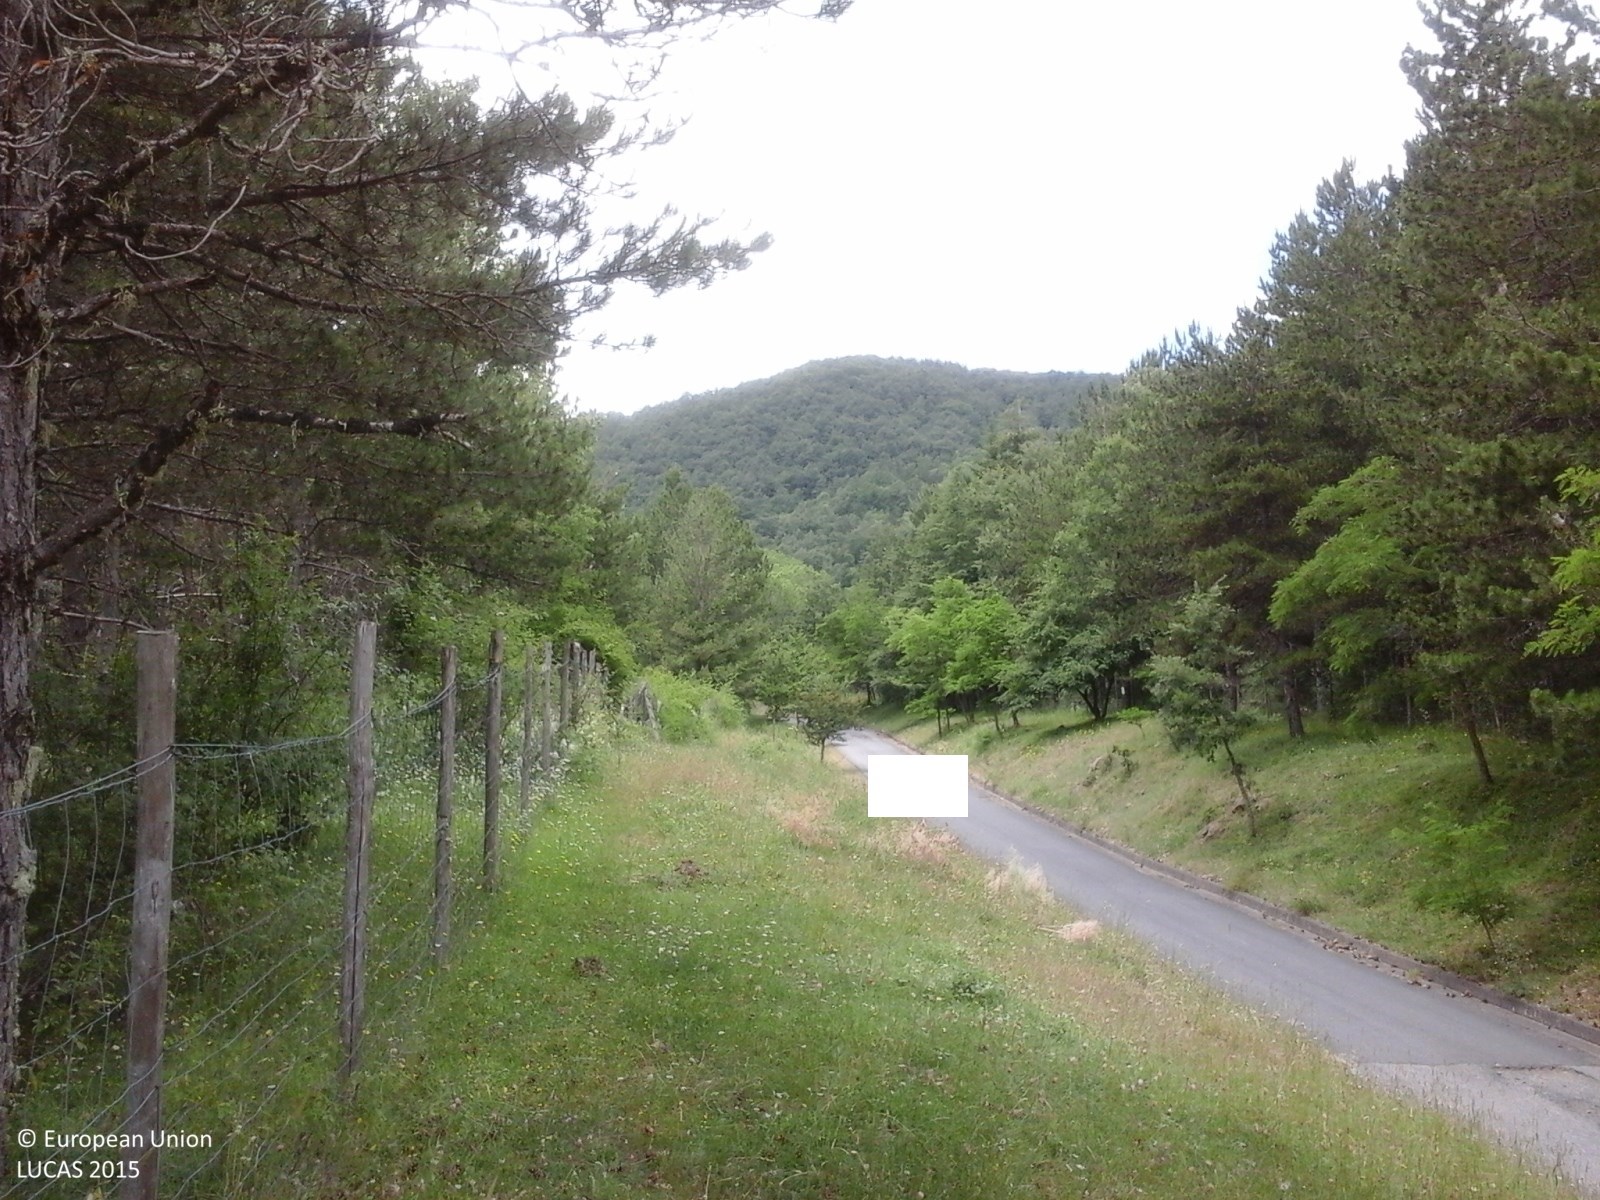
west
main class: Woodland
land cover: Broadleaved woodland
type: thermophilous deciduous forest
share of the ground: > 75 %
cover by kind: broadleaved forest trees 75 %, shrubs 15 %, herbaceous plants 10 %
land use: Amenities, museums, leisure
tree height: > 5 m
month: July
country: IT
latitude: 37.9329
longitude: 14.8481
